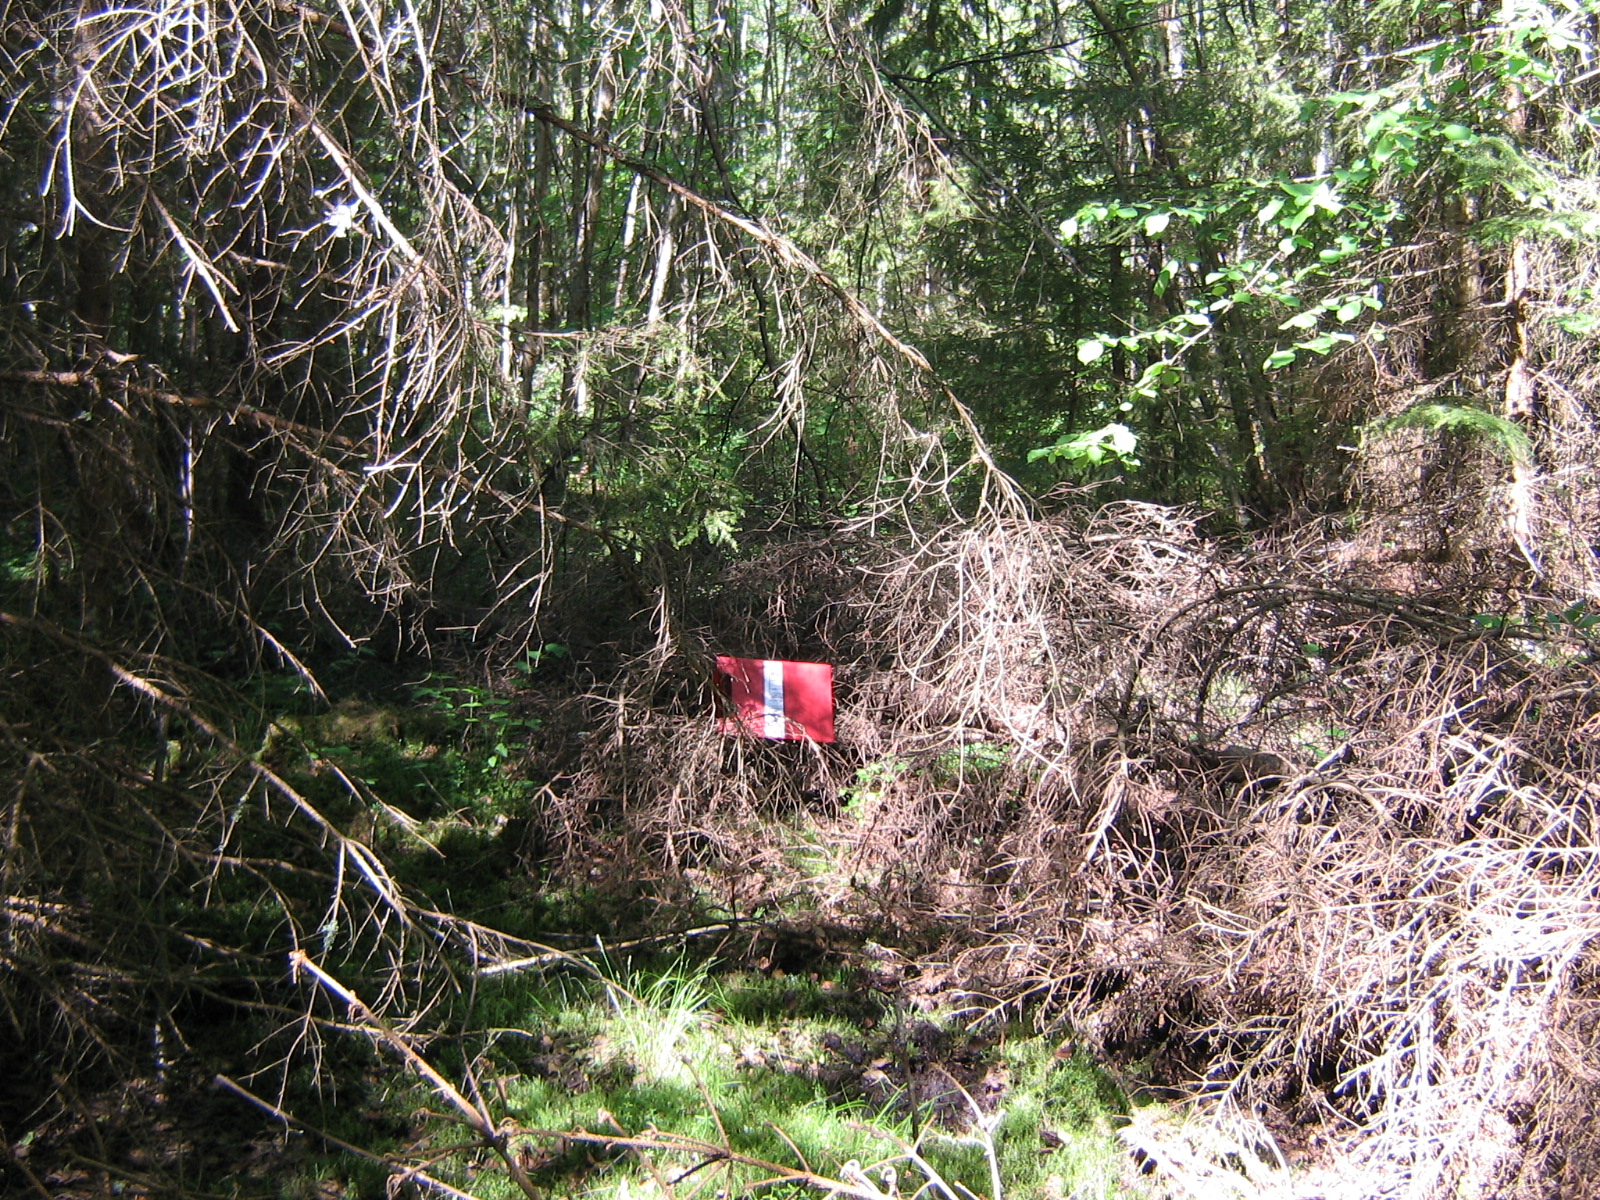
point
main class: Woodland
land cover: Spruce dominated mixed woodland
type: hemiboreal forest and nemoral coniferous forest and mixed broadleaved-coniferous forest
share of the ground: > 75 %
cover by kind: coniferous forest trees 60 %, broadleaved forest trees 40 %
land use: Forestry
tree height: > 5 m
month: June
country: LV
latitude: 57.0777
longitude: 25.9161
